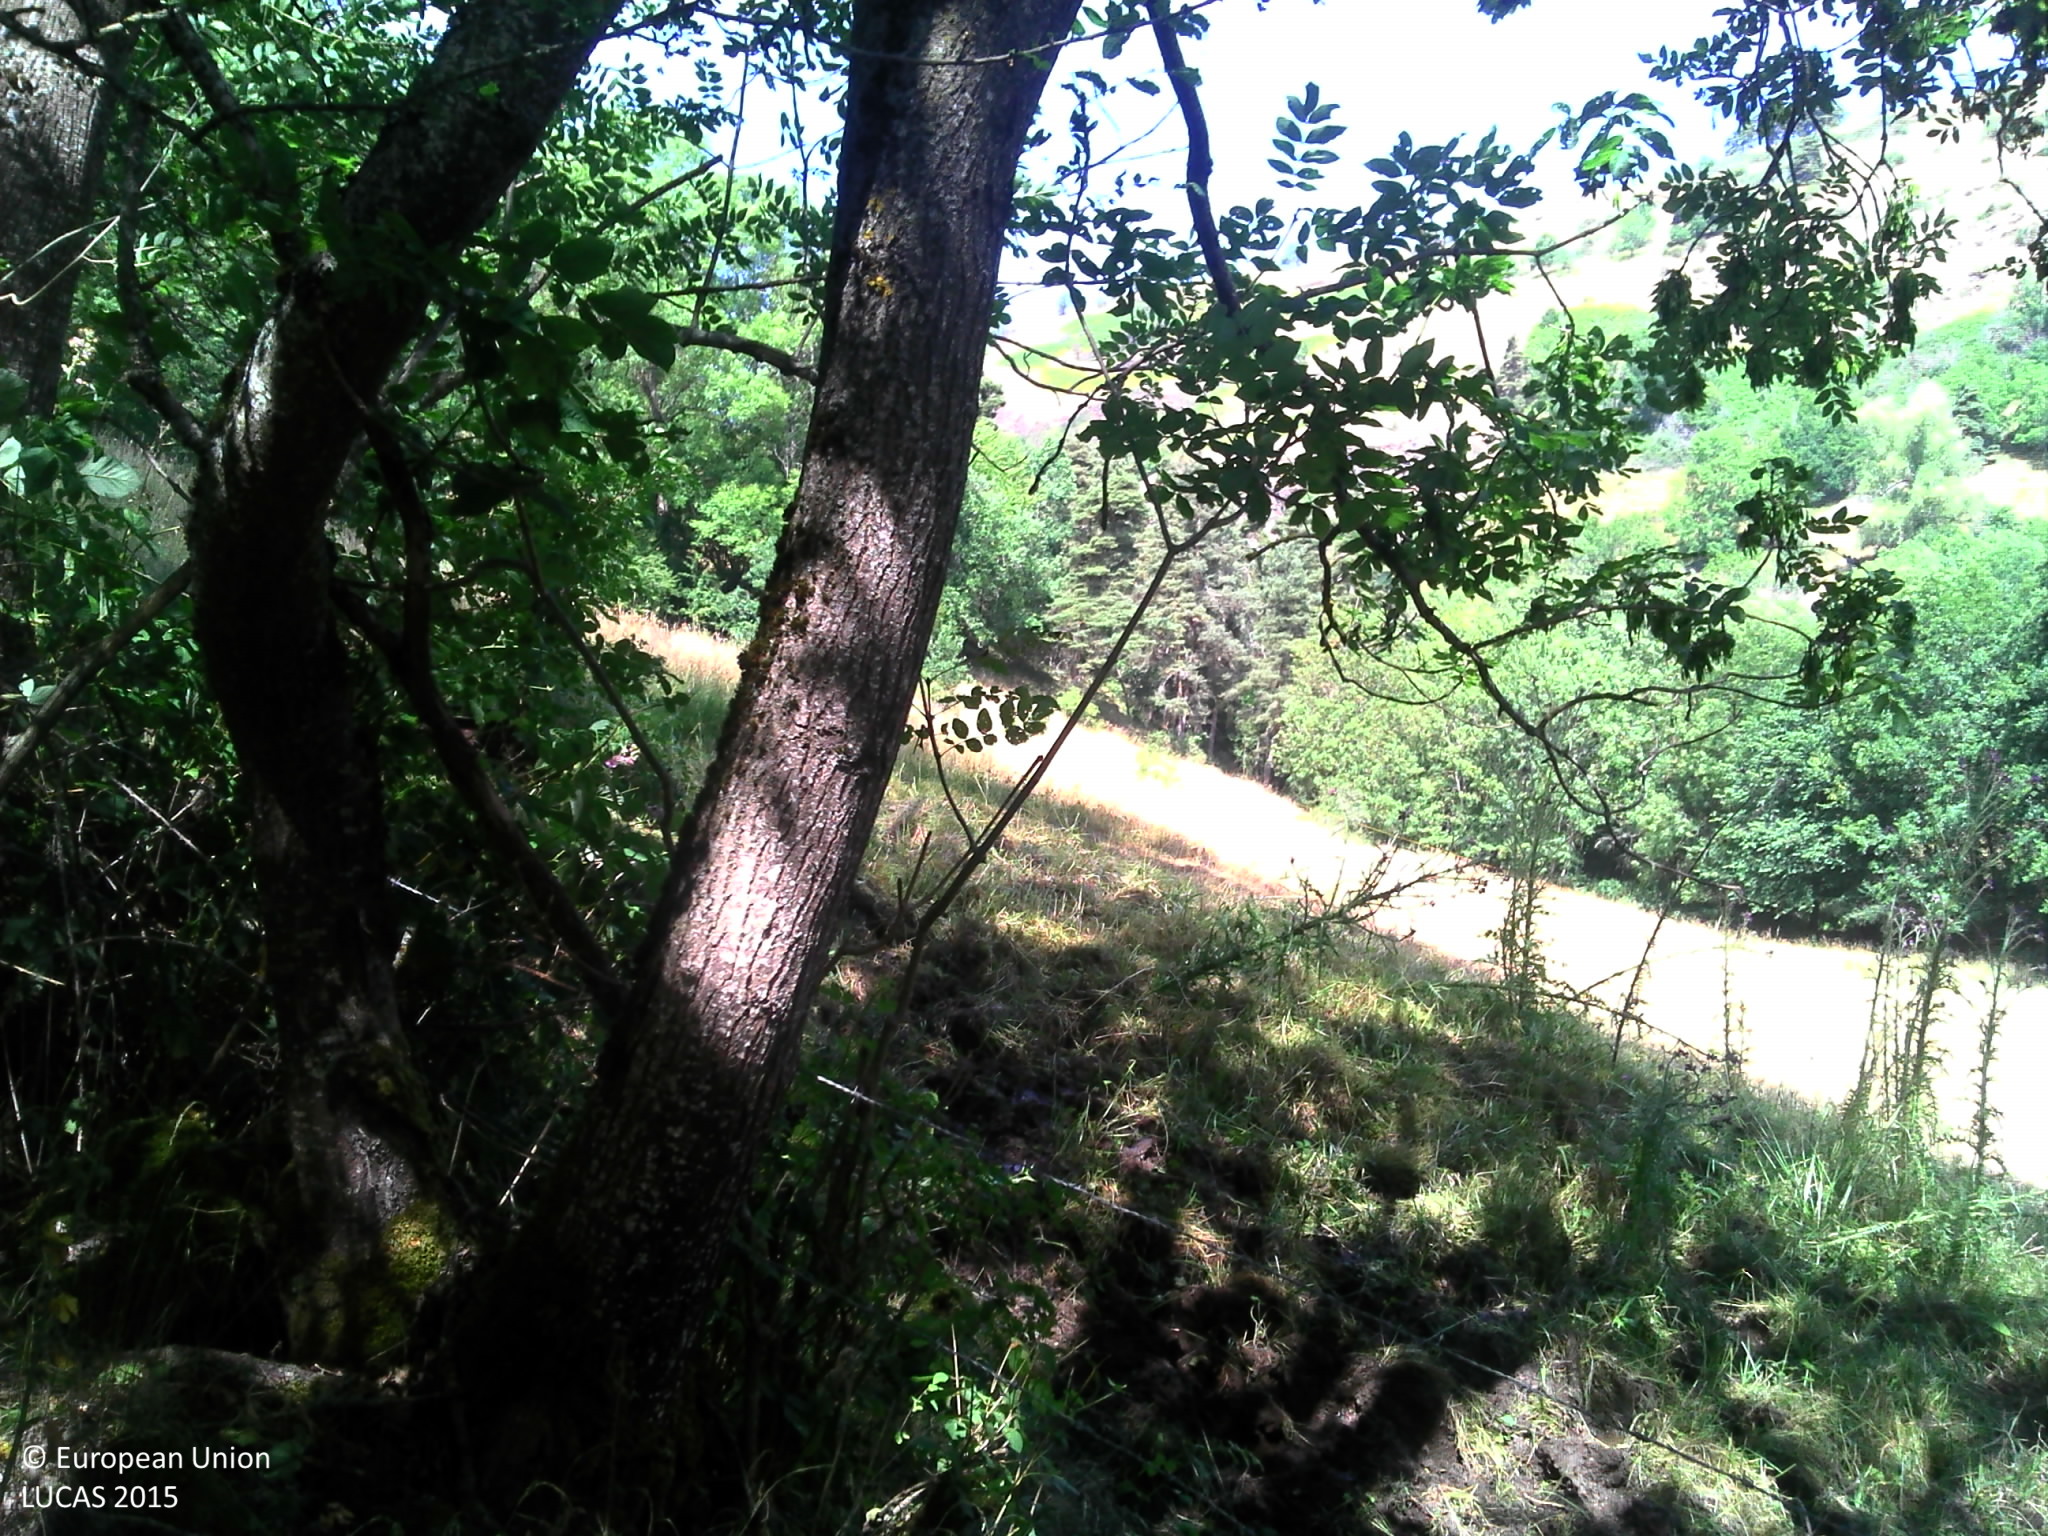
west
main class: Woodland
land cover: Broadleaved woodland
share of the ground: > 75 %
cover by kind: broadleaved forest trees 60 %, shrubs 30 %, herbaceous plants 10 %
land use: Semi-natural and natural areas not in use
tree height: > 5 m
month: July
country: FR
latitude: 45.1432
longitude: 2.9687
